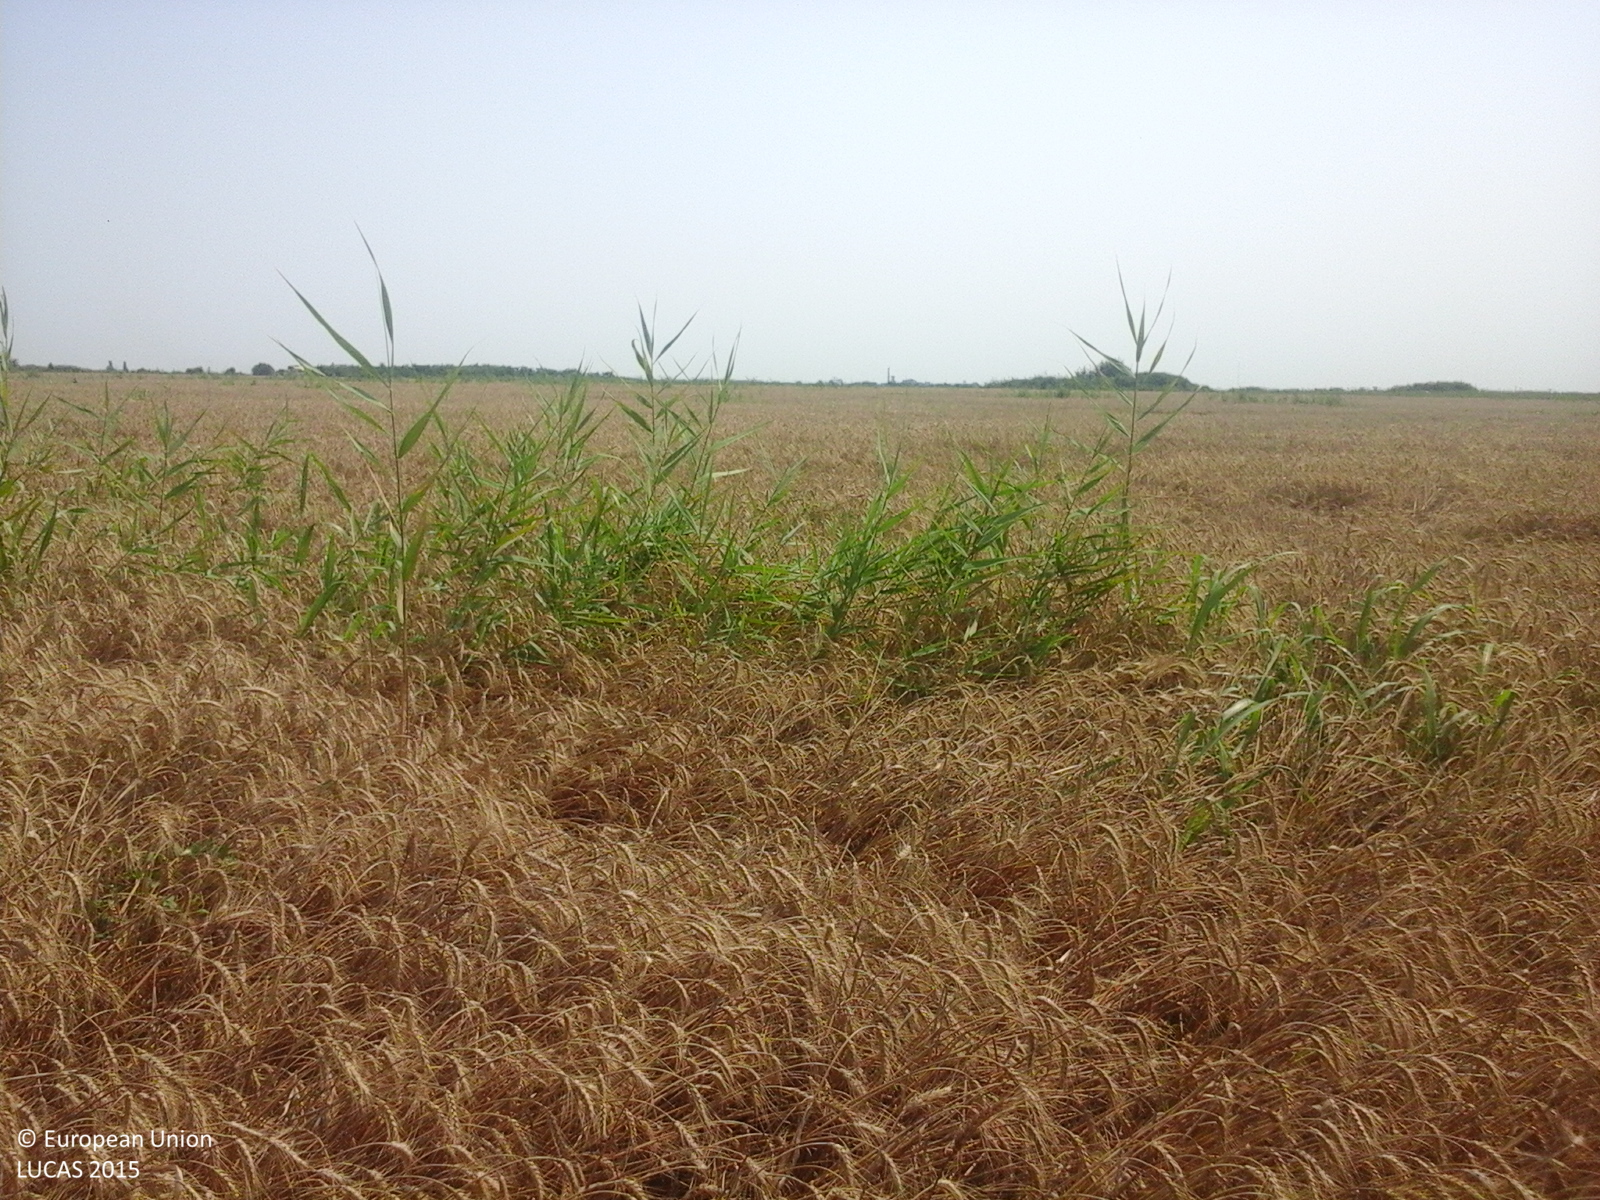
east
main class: Cropland
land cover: Durum wheat
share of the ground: > 75 %
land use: Agriculture (excluding fallow land and kitchen gardens)
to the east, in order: Durum wheat; Spontaneously vegetated surfaces; Durum wheat
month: July
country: RO
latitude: 44.7207
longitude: 26.5438
